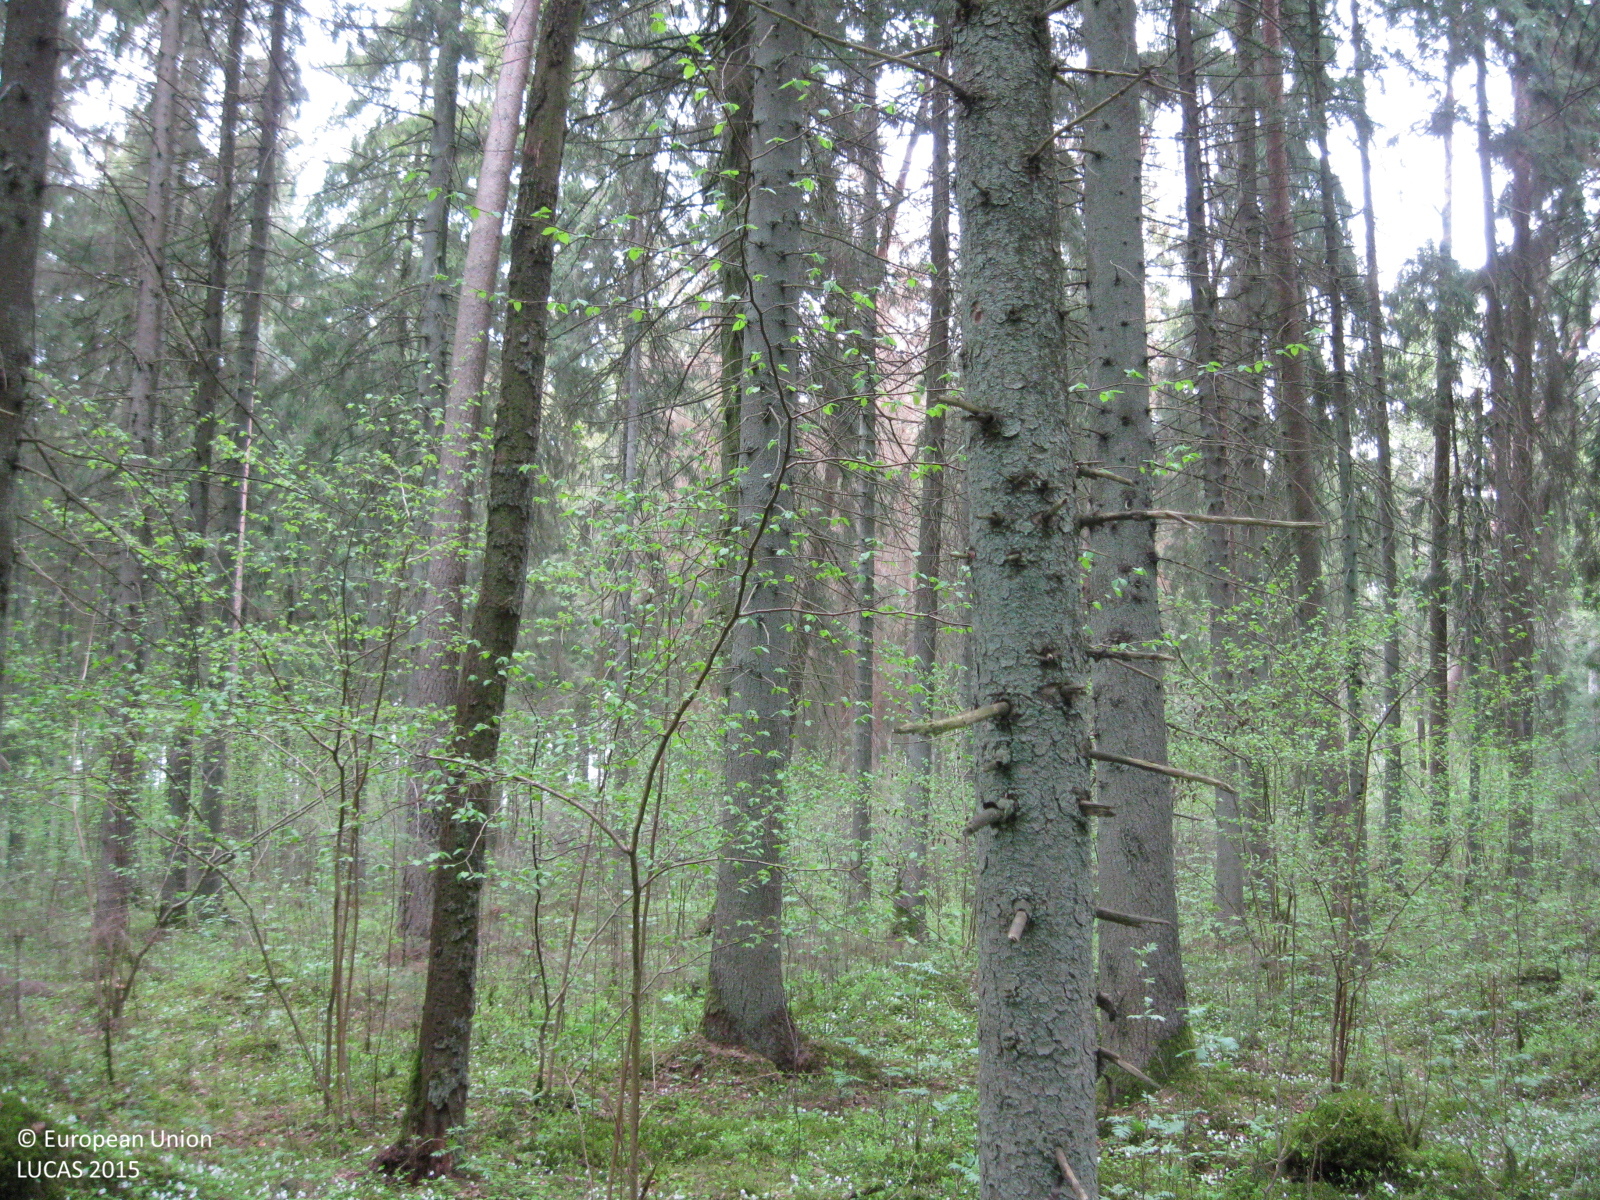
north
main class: Woodland
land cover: Spruce dominated coniferous woodland
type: hemiboreal forest and nemoral coniferous forest and mixed broadleaved-coniferous forest
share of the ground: > 75 %
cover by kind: coniferous forest trees 75 %, lichens and mosses 10 %, broadleaved forest trees 5 %, shrubs 5 %, herbaceous plants 5 %
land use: Forestry
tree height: > 5 m
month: May
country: LT
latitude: 56.1519
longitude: 24.4395
